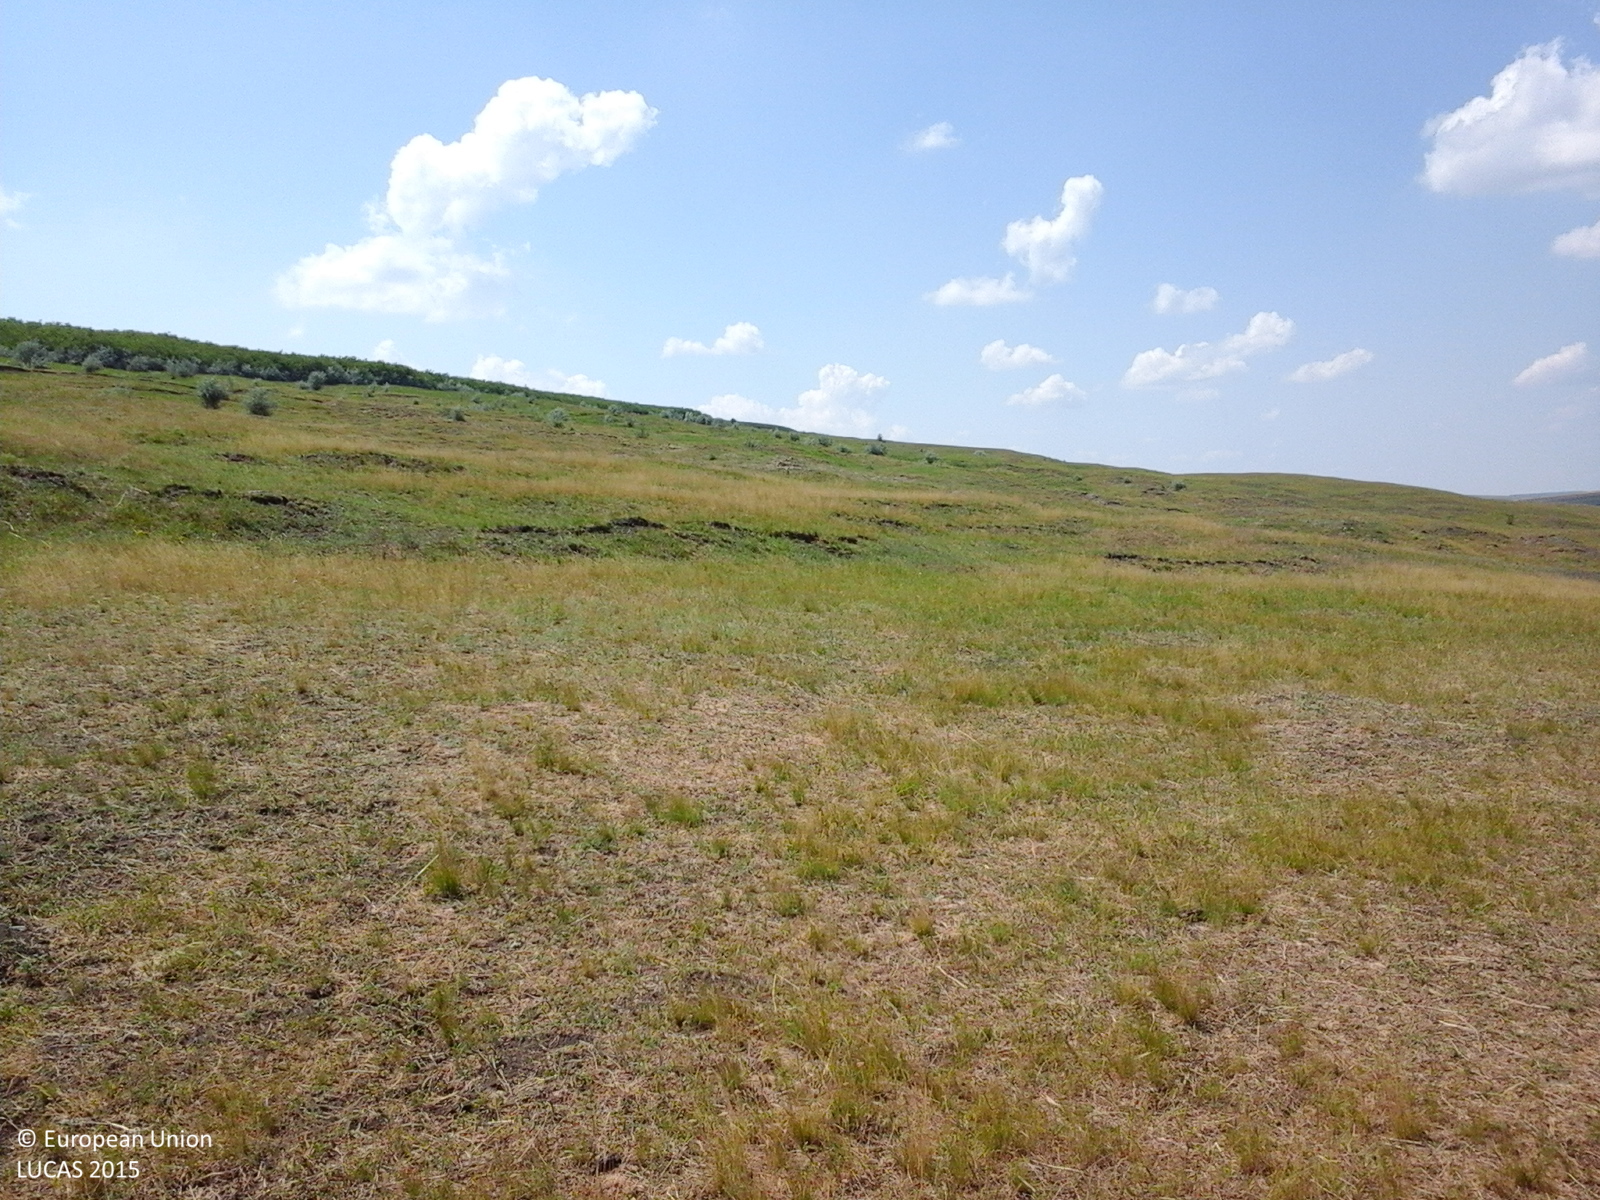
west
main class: Grassland
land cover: Grassland without tree/shrub cover
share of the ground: > 75 %
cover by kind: herbaceous plants 100 %
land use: Agriculture (excluding fallow land and kitchen gardens)
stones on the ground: < 10 %
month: June
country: RO
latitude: 47.6014
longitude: 27.0368
